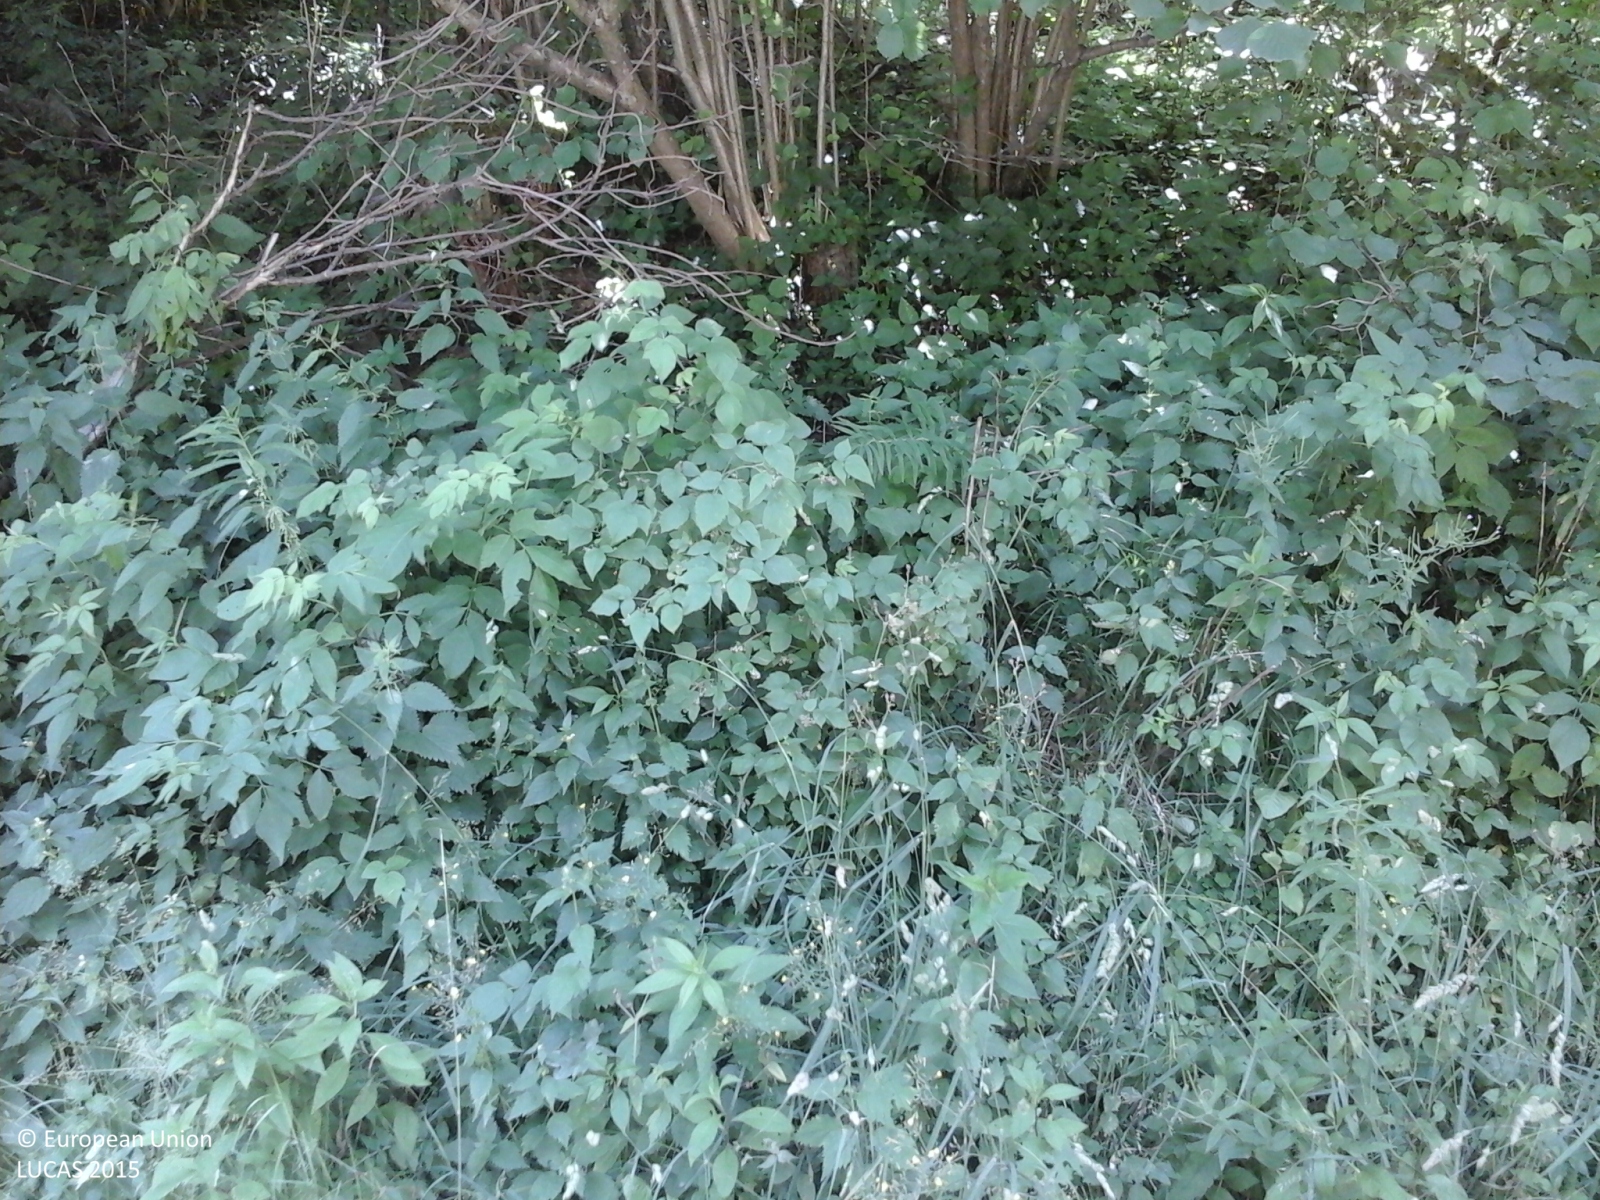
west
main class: Woodland
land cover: Spruce dominated coniferous woodland
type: alpine coniferous forest
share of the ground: 50 - 75 %
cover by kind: coniferous forest trees 100 %
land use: Forestry
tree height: > 5 m
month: July
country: IT
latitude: 46.8254
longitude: 11.6106
